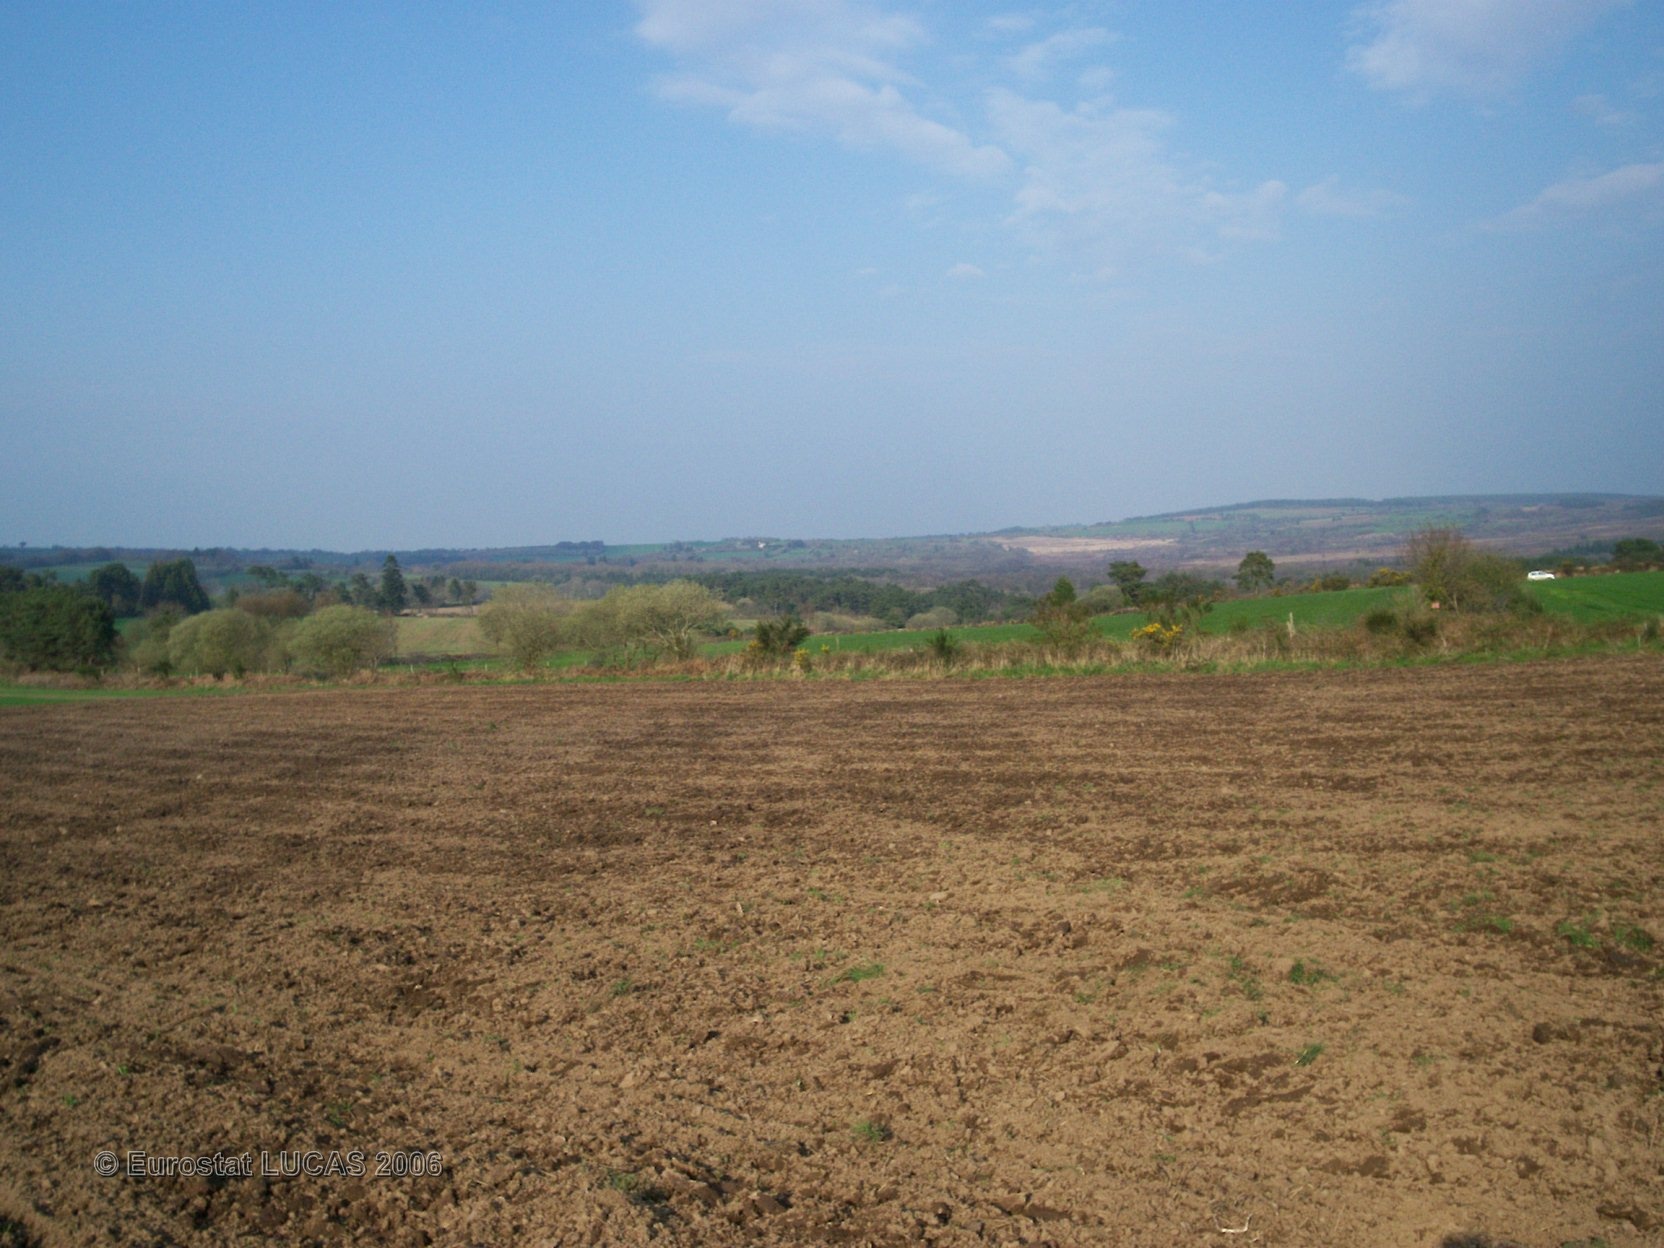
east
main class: Cropland
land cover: Maize
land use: Agriculture (excluding fallow land and kitchen gardens)
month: June
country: FR
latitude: 48.4581
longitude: -3.6998
